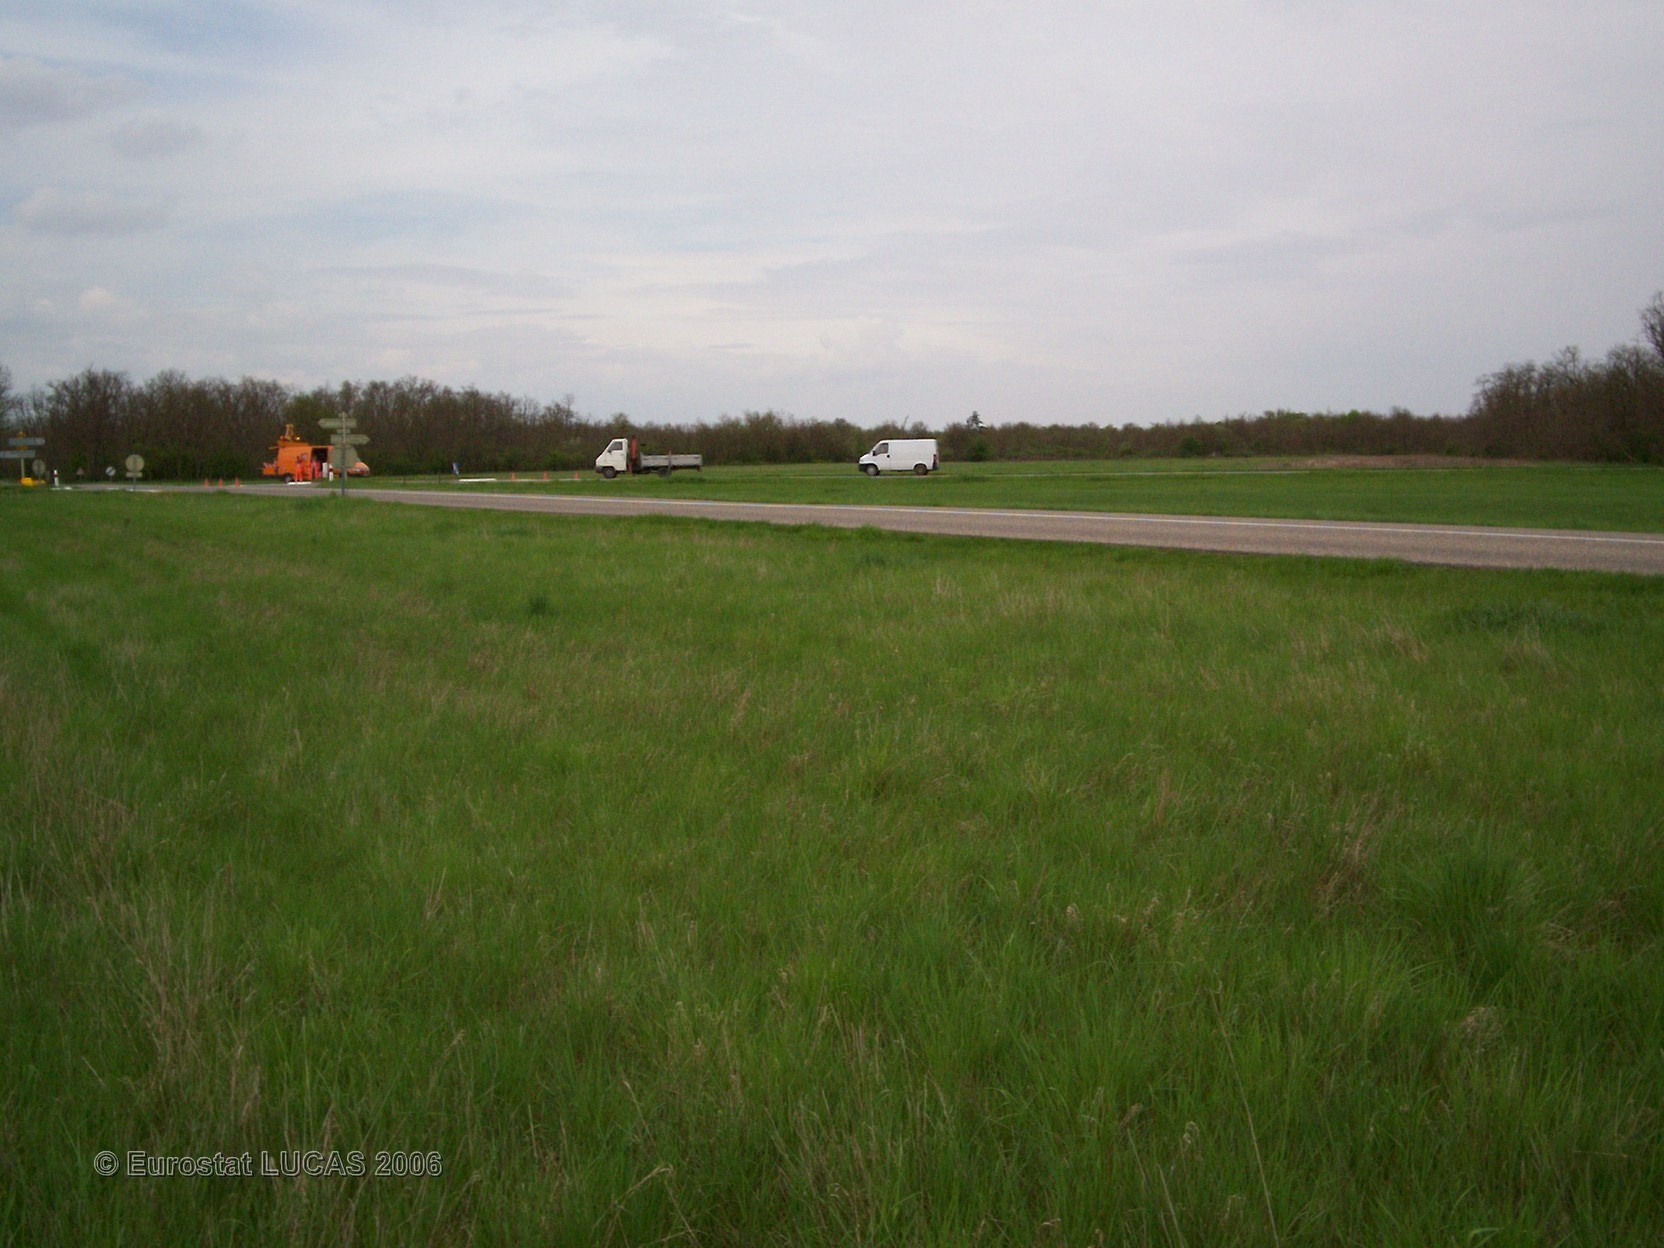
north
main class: Grassland
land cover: Grassland without tree/shrub cover
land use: Agriculture (excluding fallow land and kitchen gardens)
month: April
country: FR
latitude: 47.9412
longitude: 7.4175
